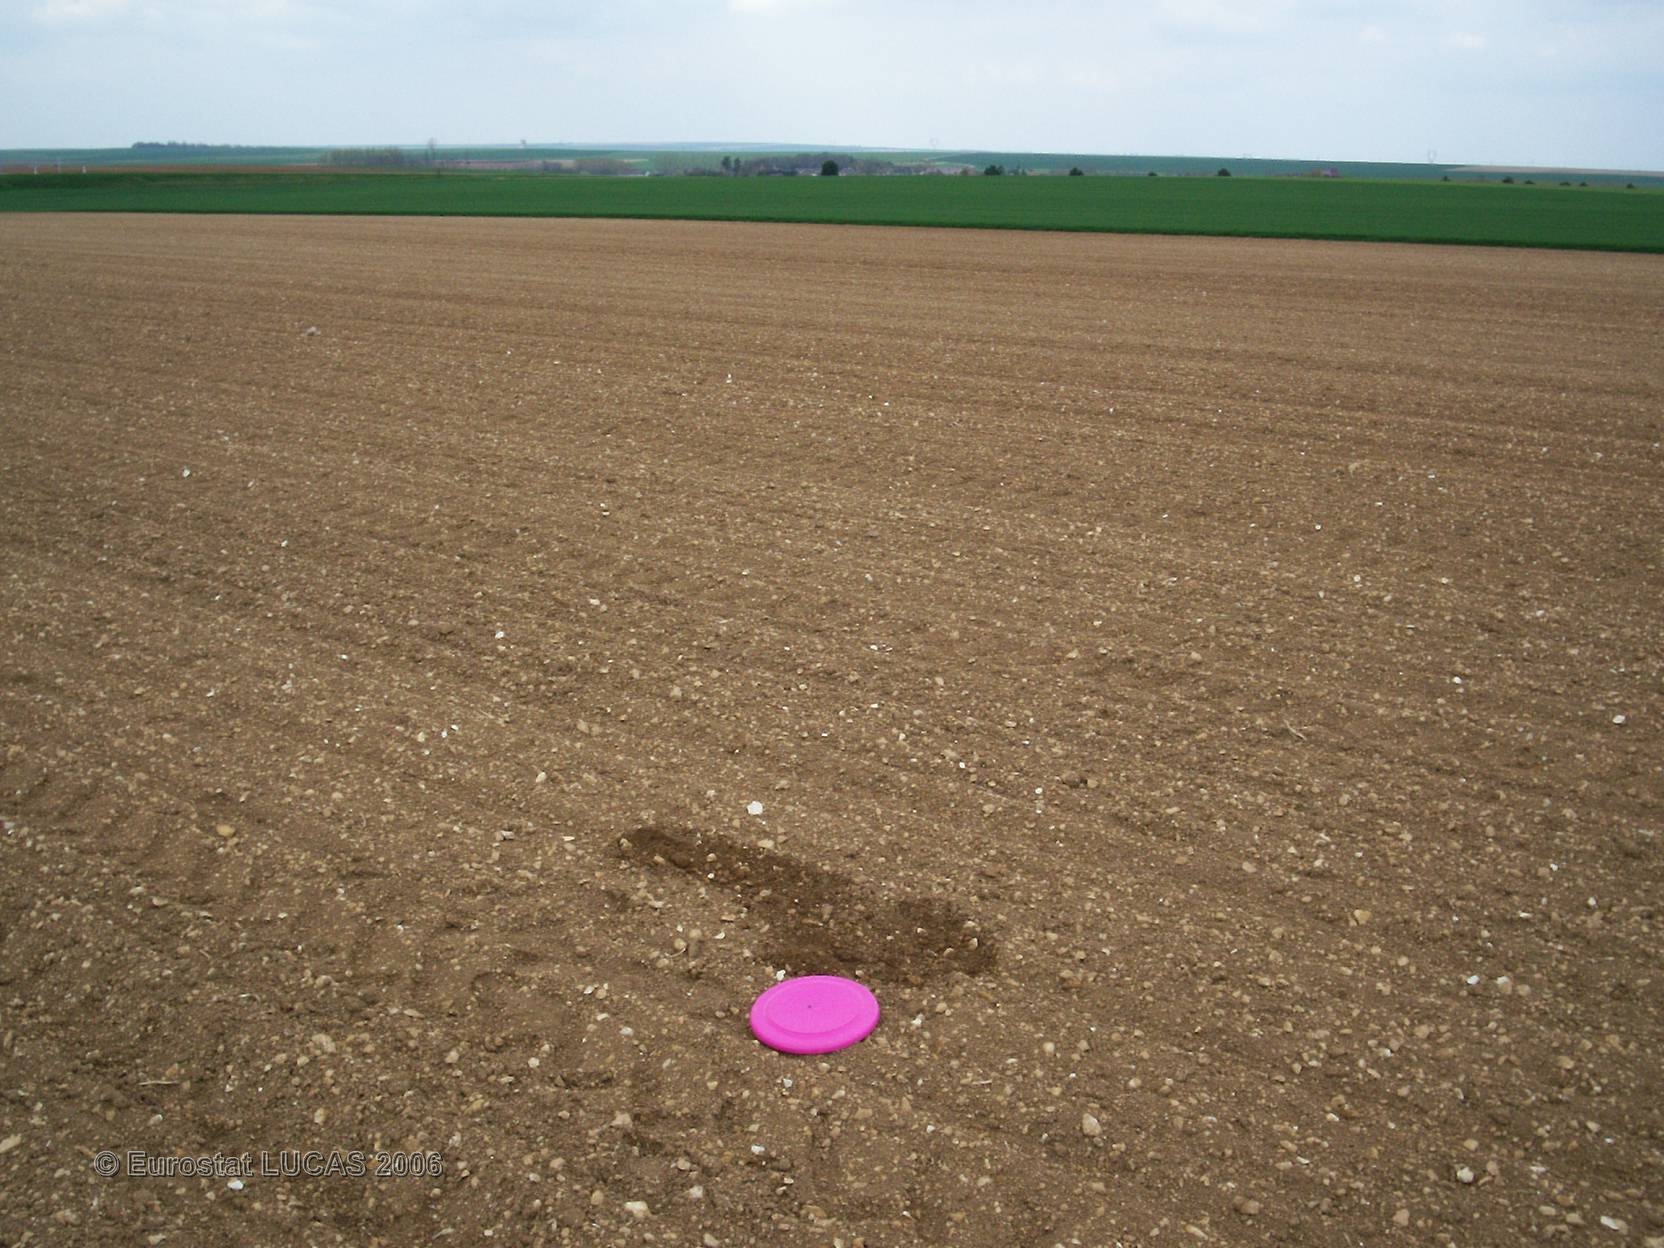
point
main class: Cropland
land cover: Sugar beet
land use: Agriculture (excluding fallow land and kitchen gardens)
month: April
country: FR
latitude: 48.5019
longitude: 4.5159
